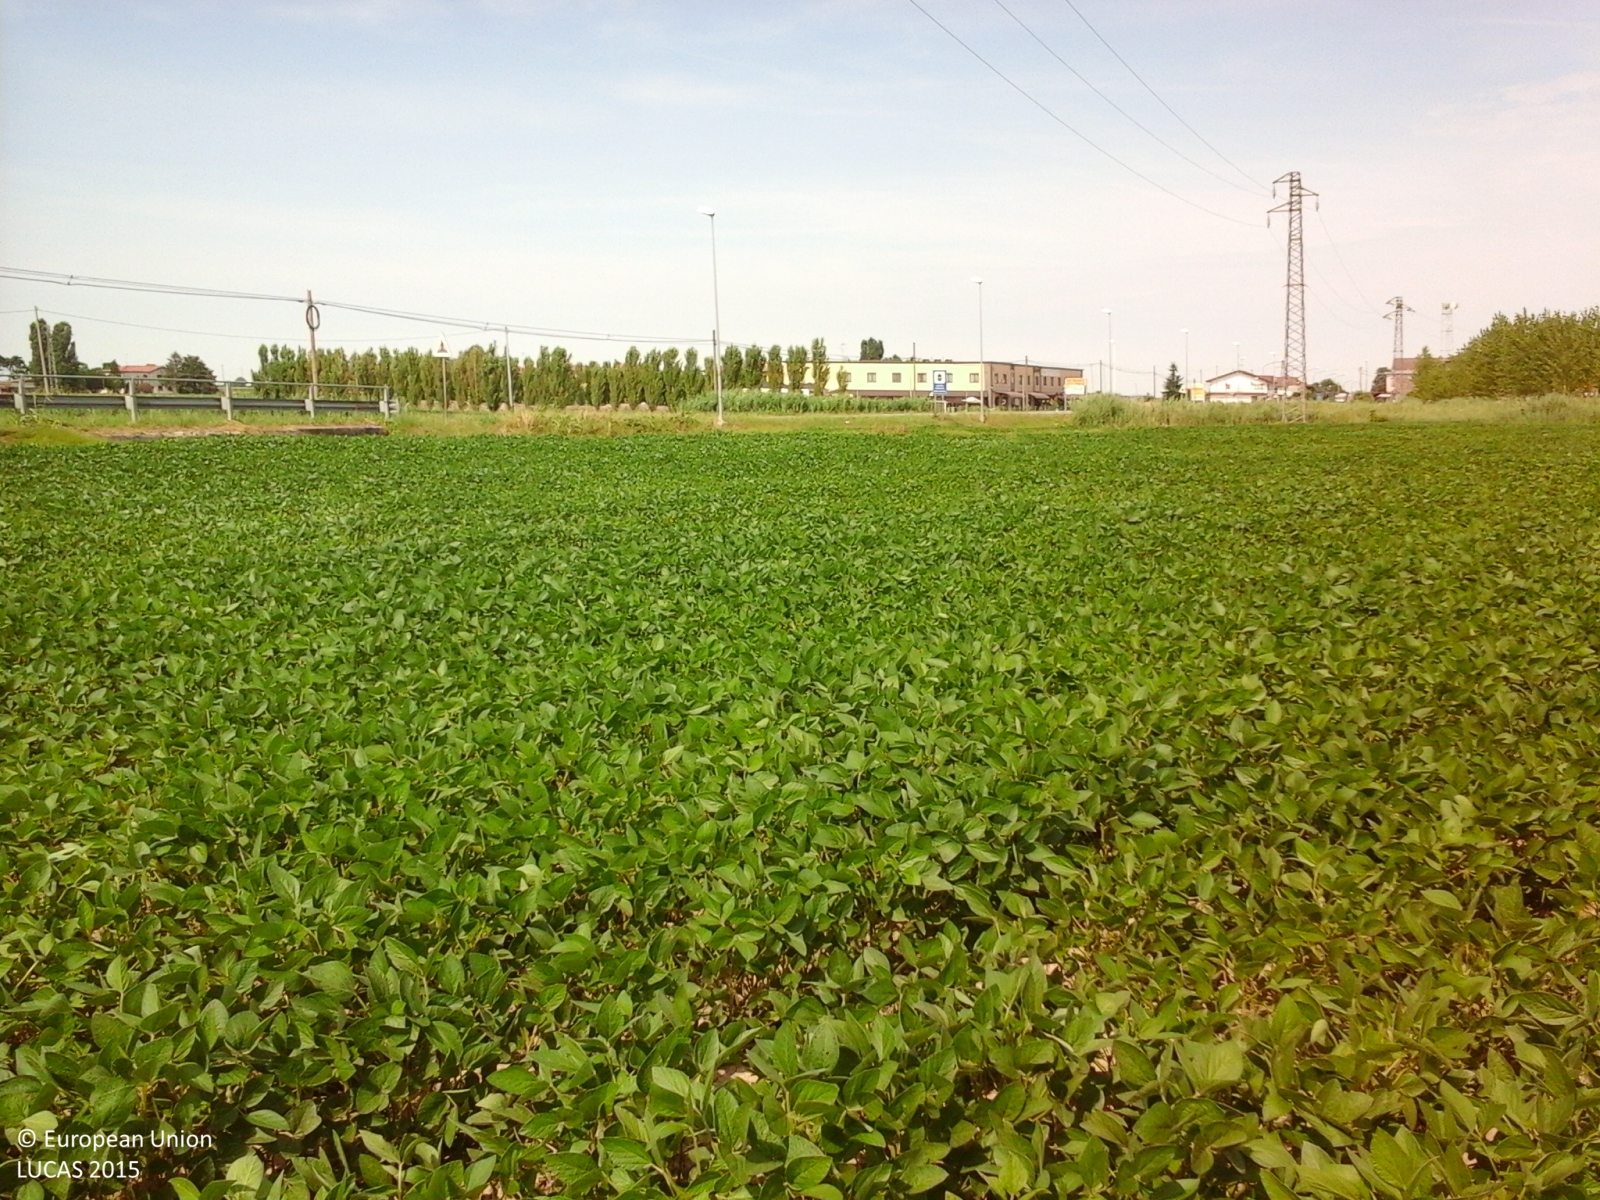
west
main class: Cropland
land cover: Soya
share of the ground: > 75 %
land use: Agriculture (excluding fallow land and kitchen gardens)
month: June
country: IT
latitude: 44.9538
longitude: 12.4167
